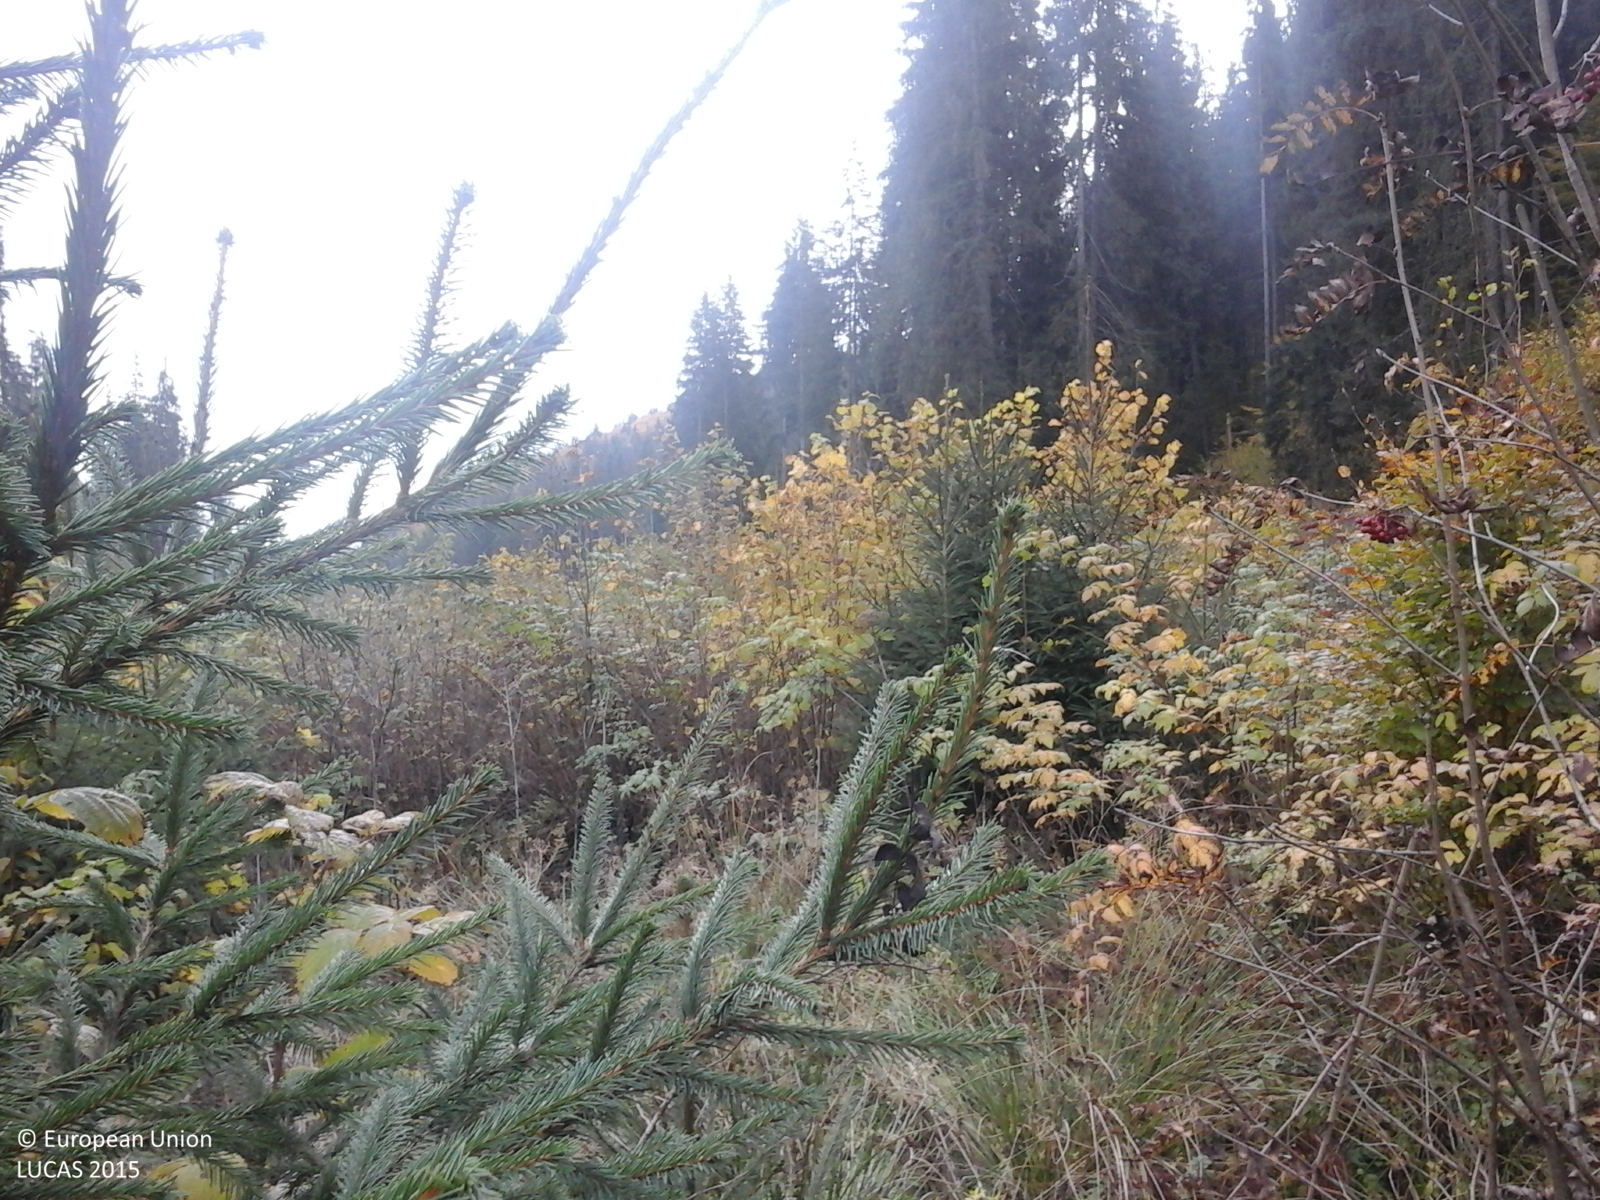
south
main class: Shrubland
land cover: Shrubland with sparse tree cover
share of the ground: > 75 %
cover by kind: shrubs 95 %, broadleaved forest trees 5 %
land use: Semi-natural and natural areas not in use
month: October
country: RO
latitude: 46.5184
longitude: 25.3428
